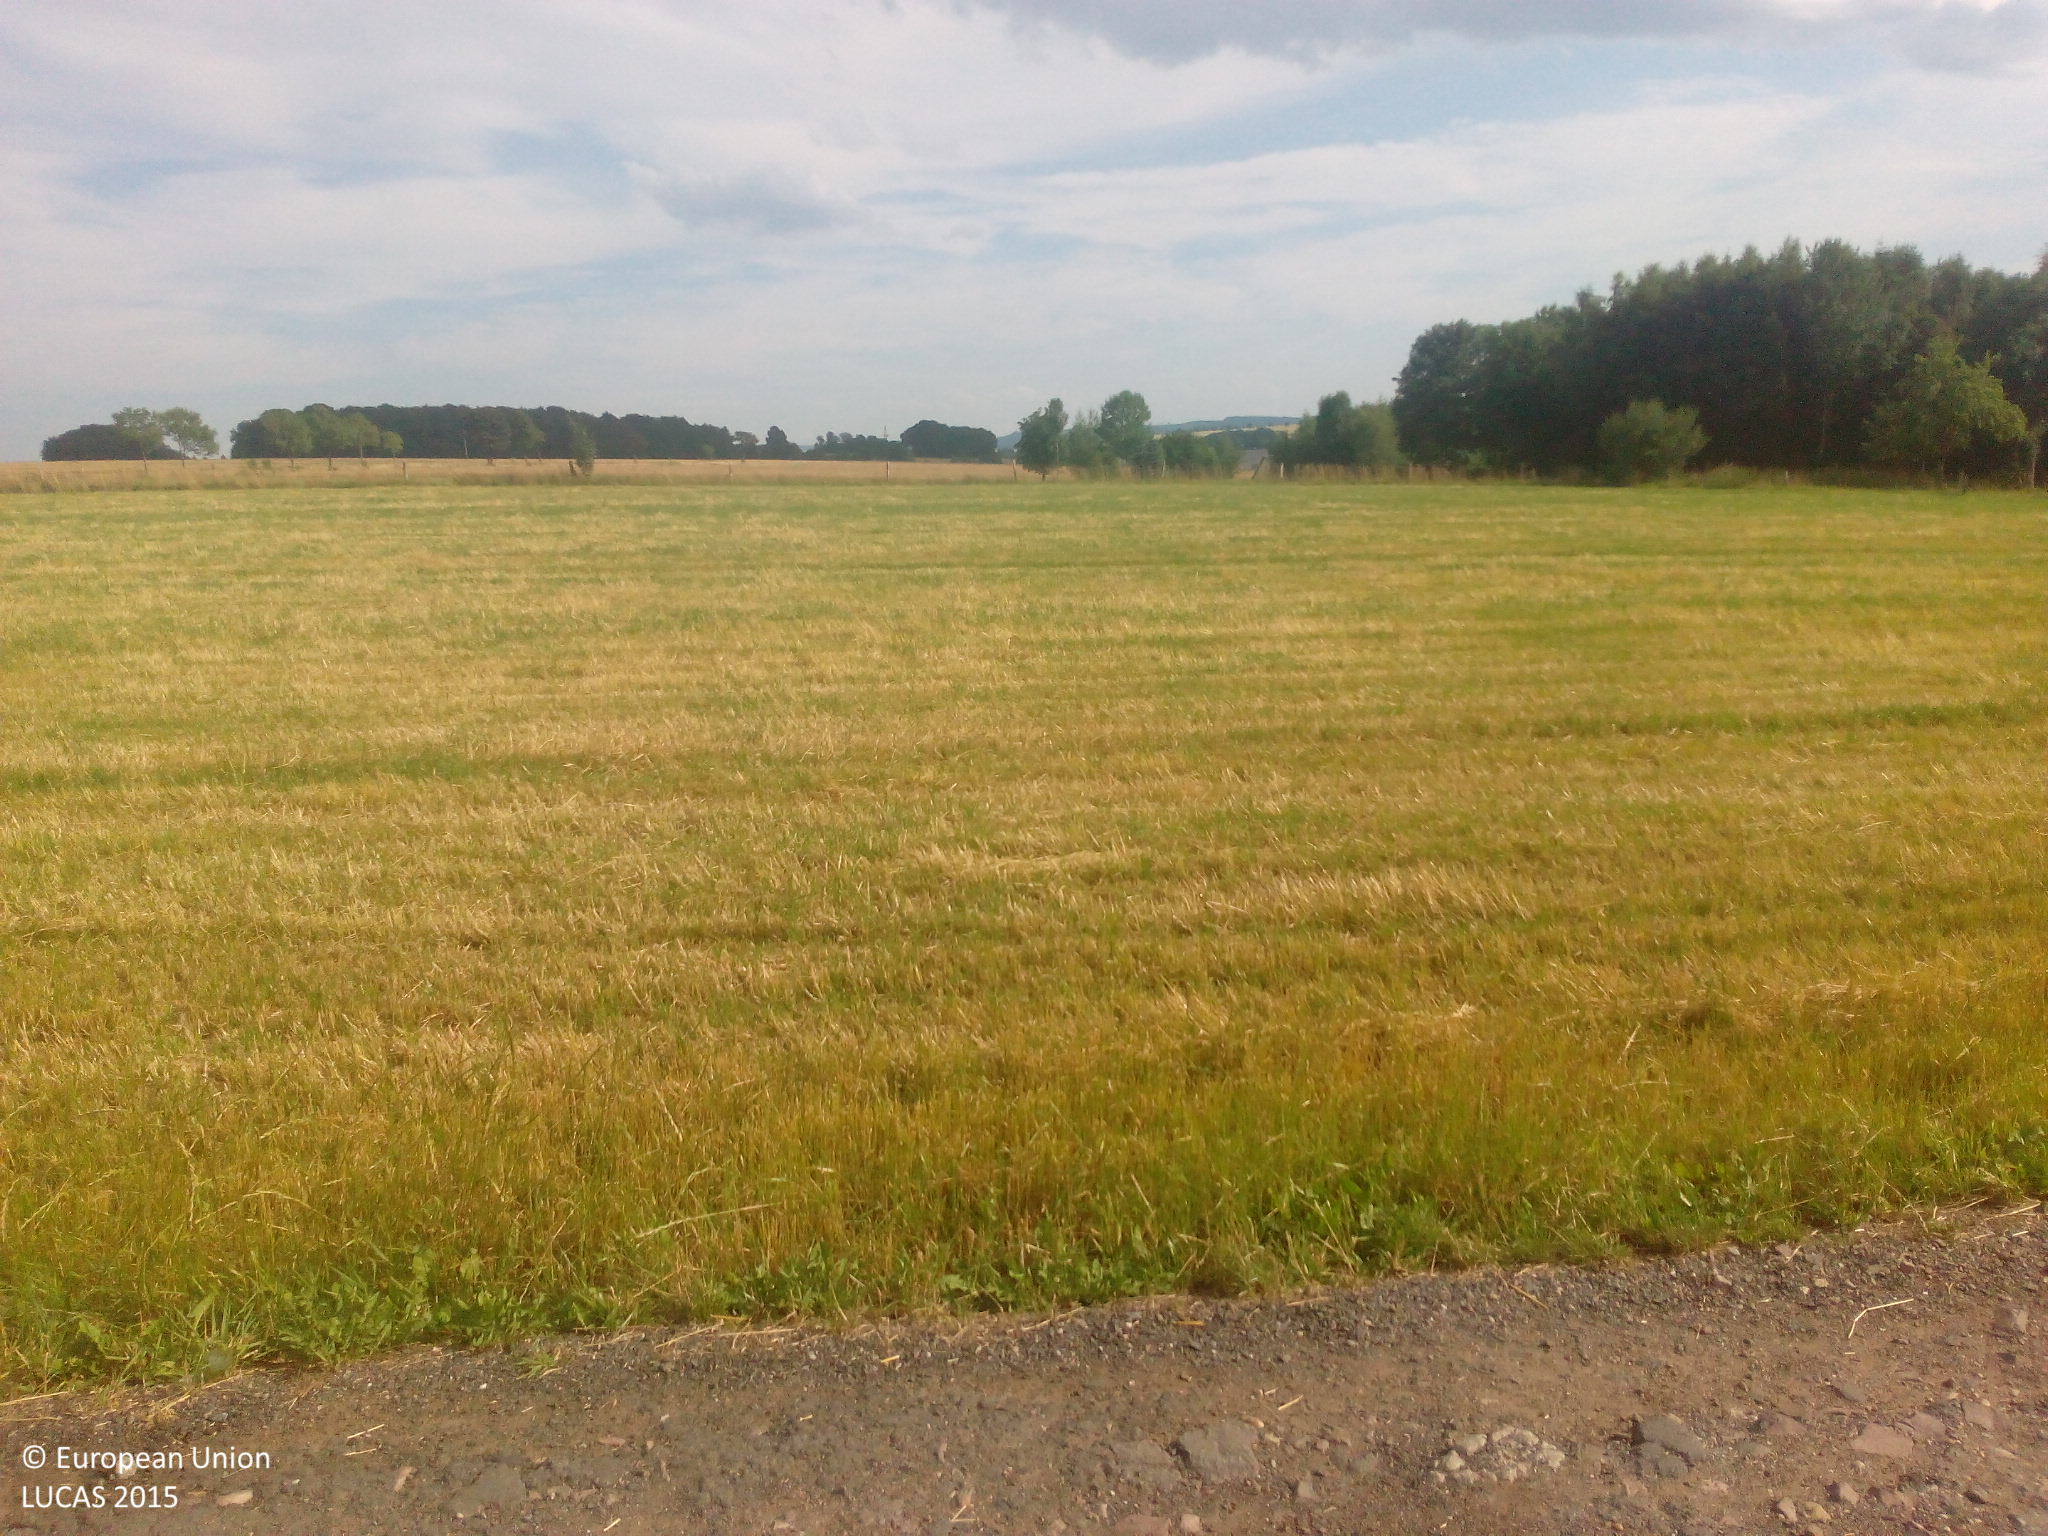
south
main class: Cropland
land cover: Triticale
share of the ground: > 75 %
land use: Agriculture (excluding fallow land and kitchen gardens)
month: July
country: DE
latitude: 50.9040
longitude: 13.5129
